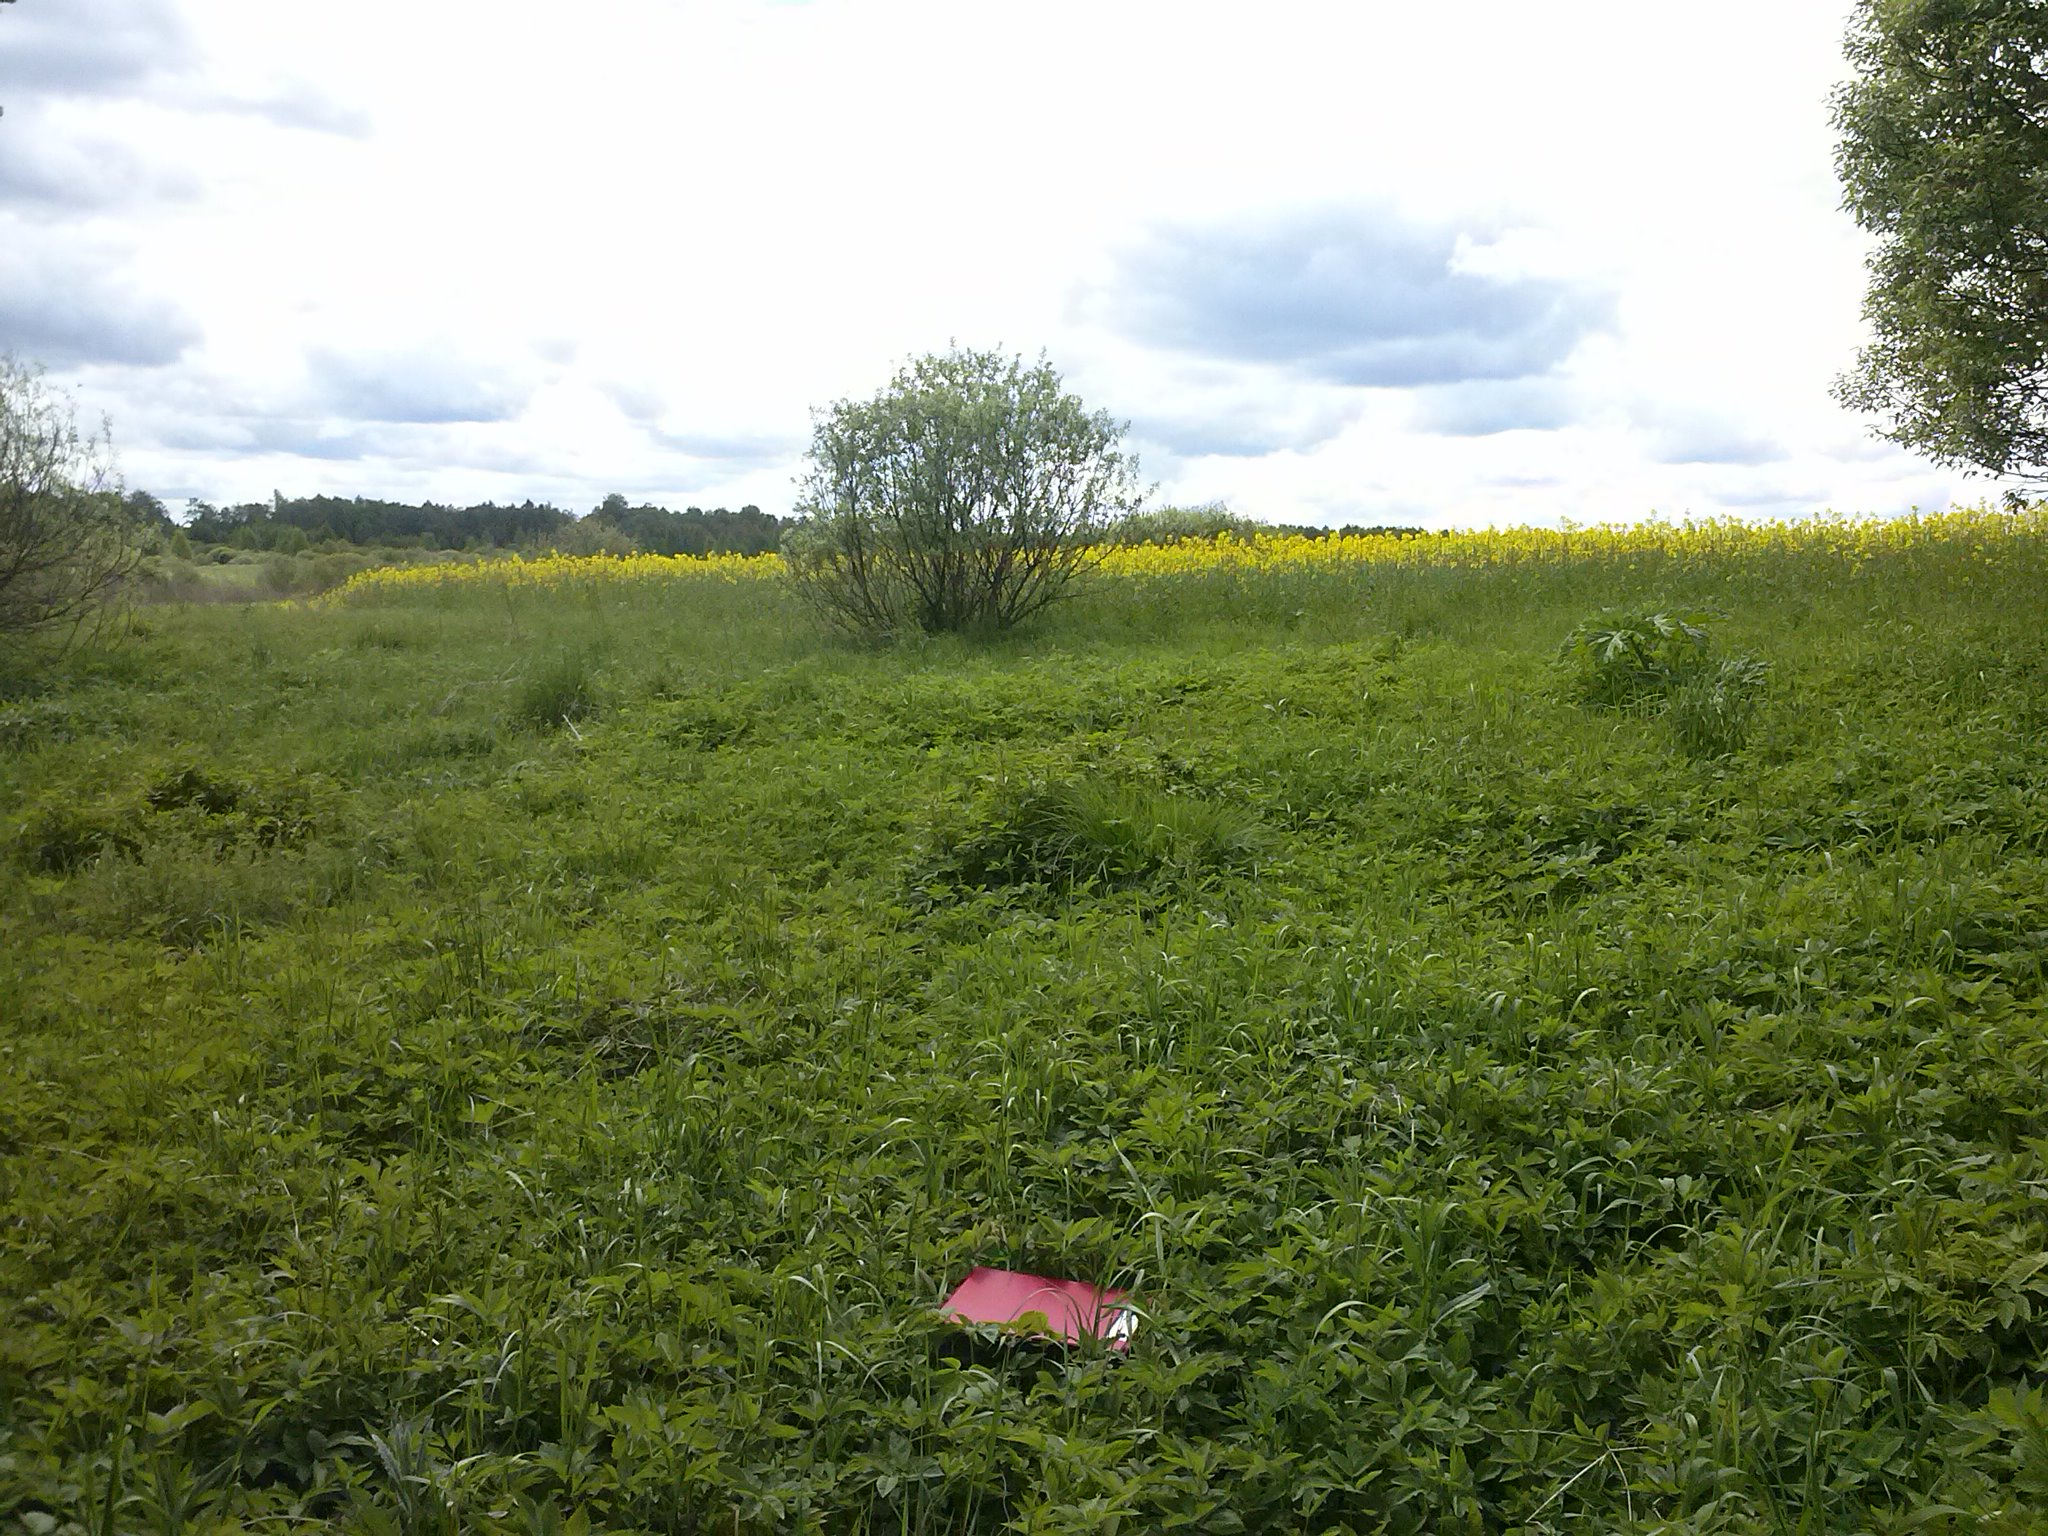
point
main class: Grassland
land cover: Grassland with sparse tree/shrub cover
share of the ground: > 75 %
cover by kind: herbaceous plants 90 %, broadleaved forest trees 5 %, shrubs 5 %
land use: Agriculture (excluding fallow land and kitchen gardens)
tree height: < 5 m
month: May
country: LV
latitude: 56.1706
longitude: 27.7612
